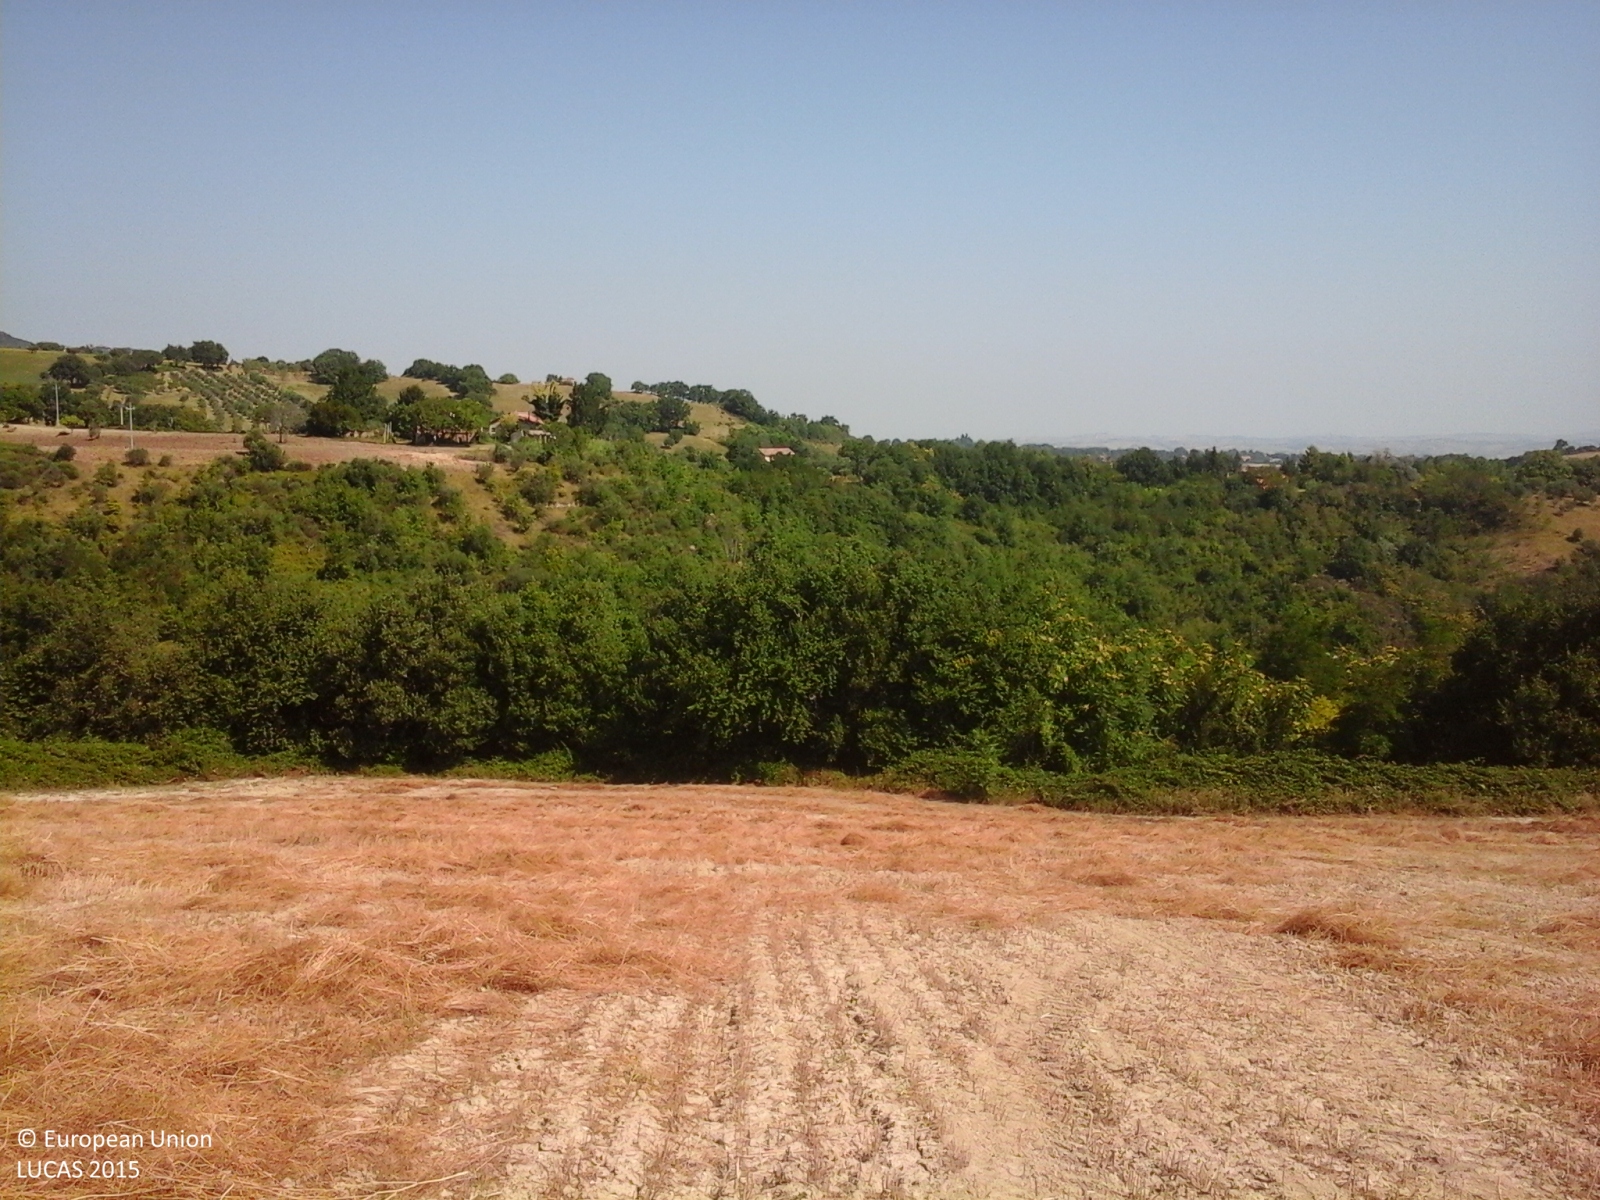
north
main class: Cropland
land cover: Other non-permanent industrial crops
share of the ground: > 75 %
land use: Agriculture (excluding fallow land and kitchen gardens)
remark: Harvested field
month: August
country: IT
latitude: 43.3243
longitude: 13.2595
